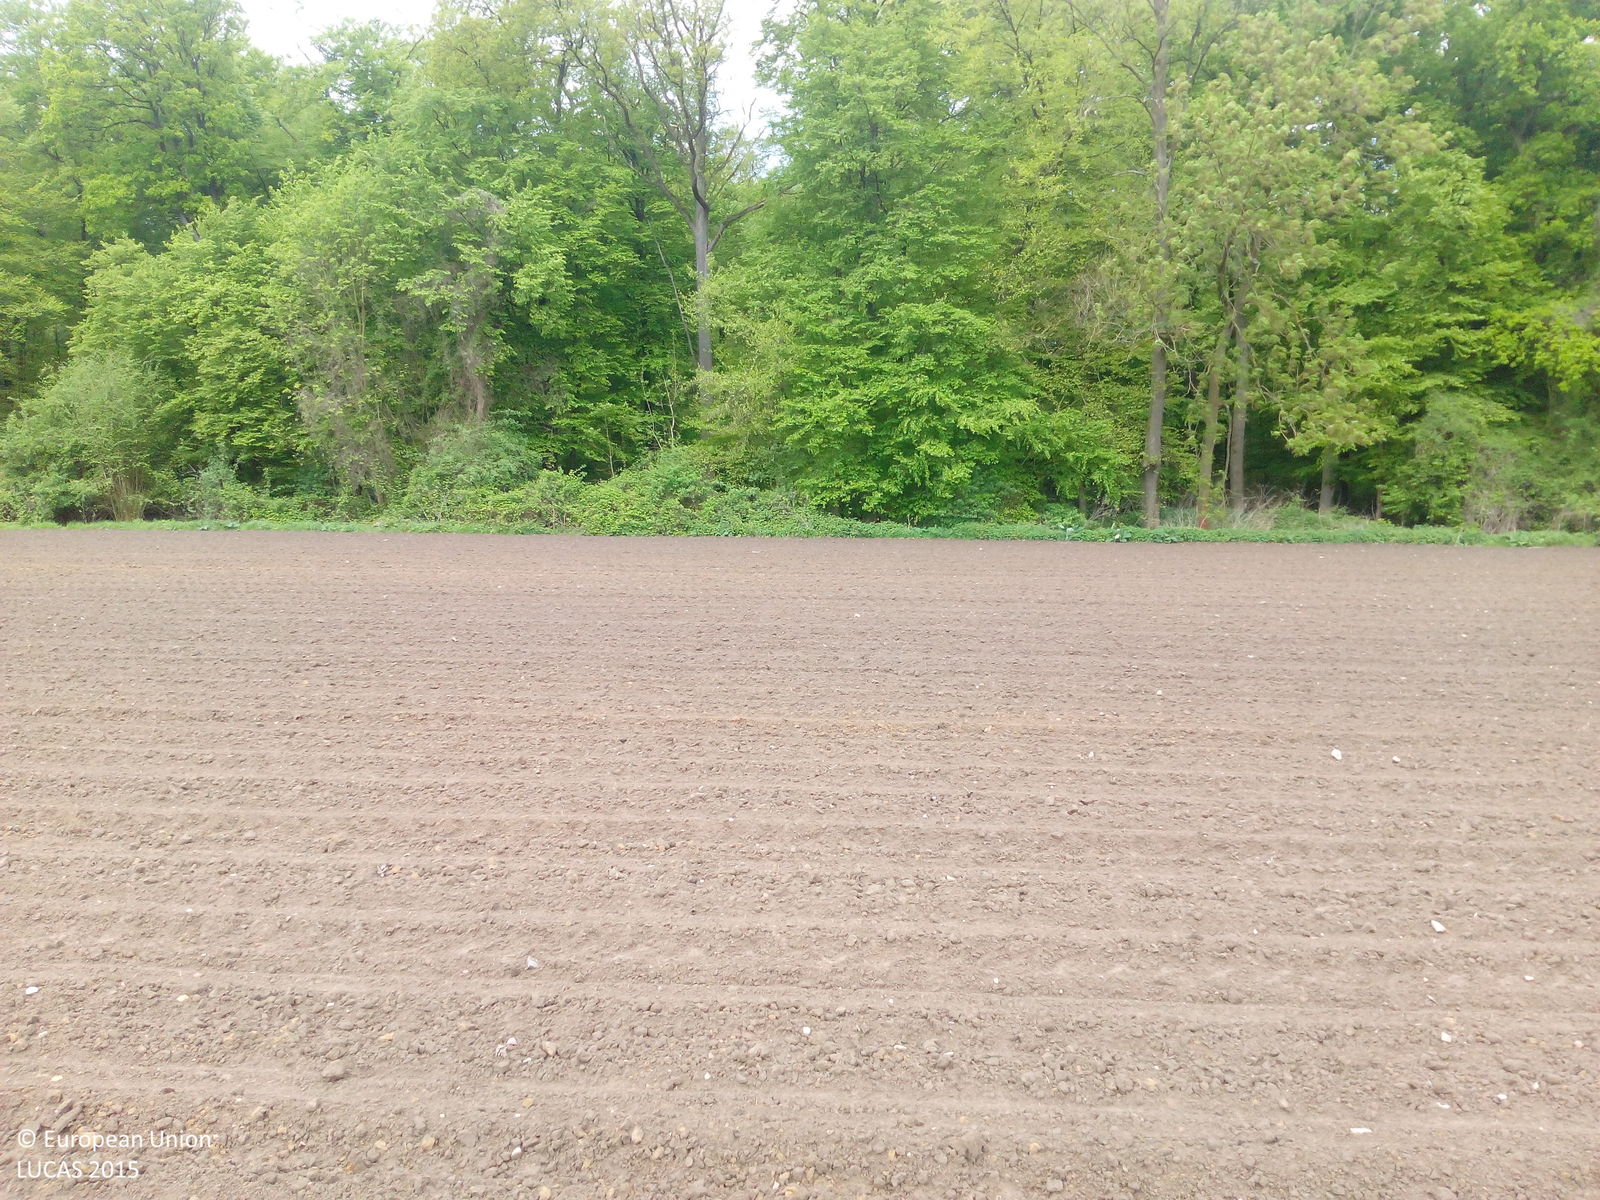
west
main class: Cropland
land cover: Maize
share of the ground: < 10 %
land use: Agriculture (excluding fallow land and kitchen gardens)
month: May
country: DE
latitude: 51.8288
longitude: 7.4610
